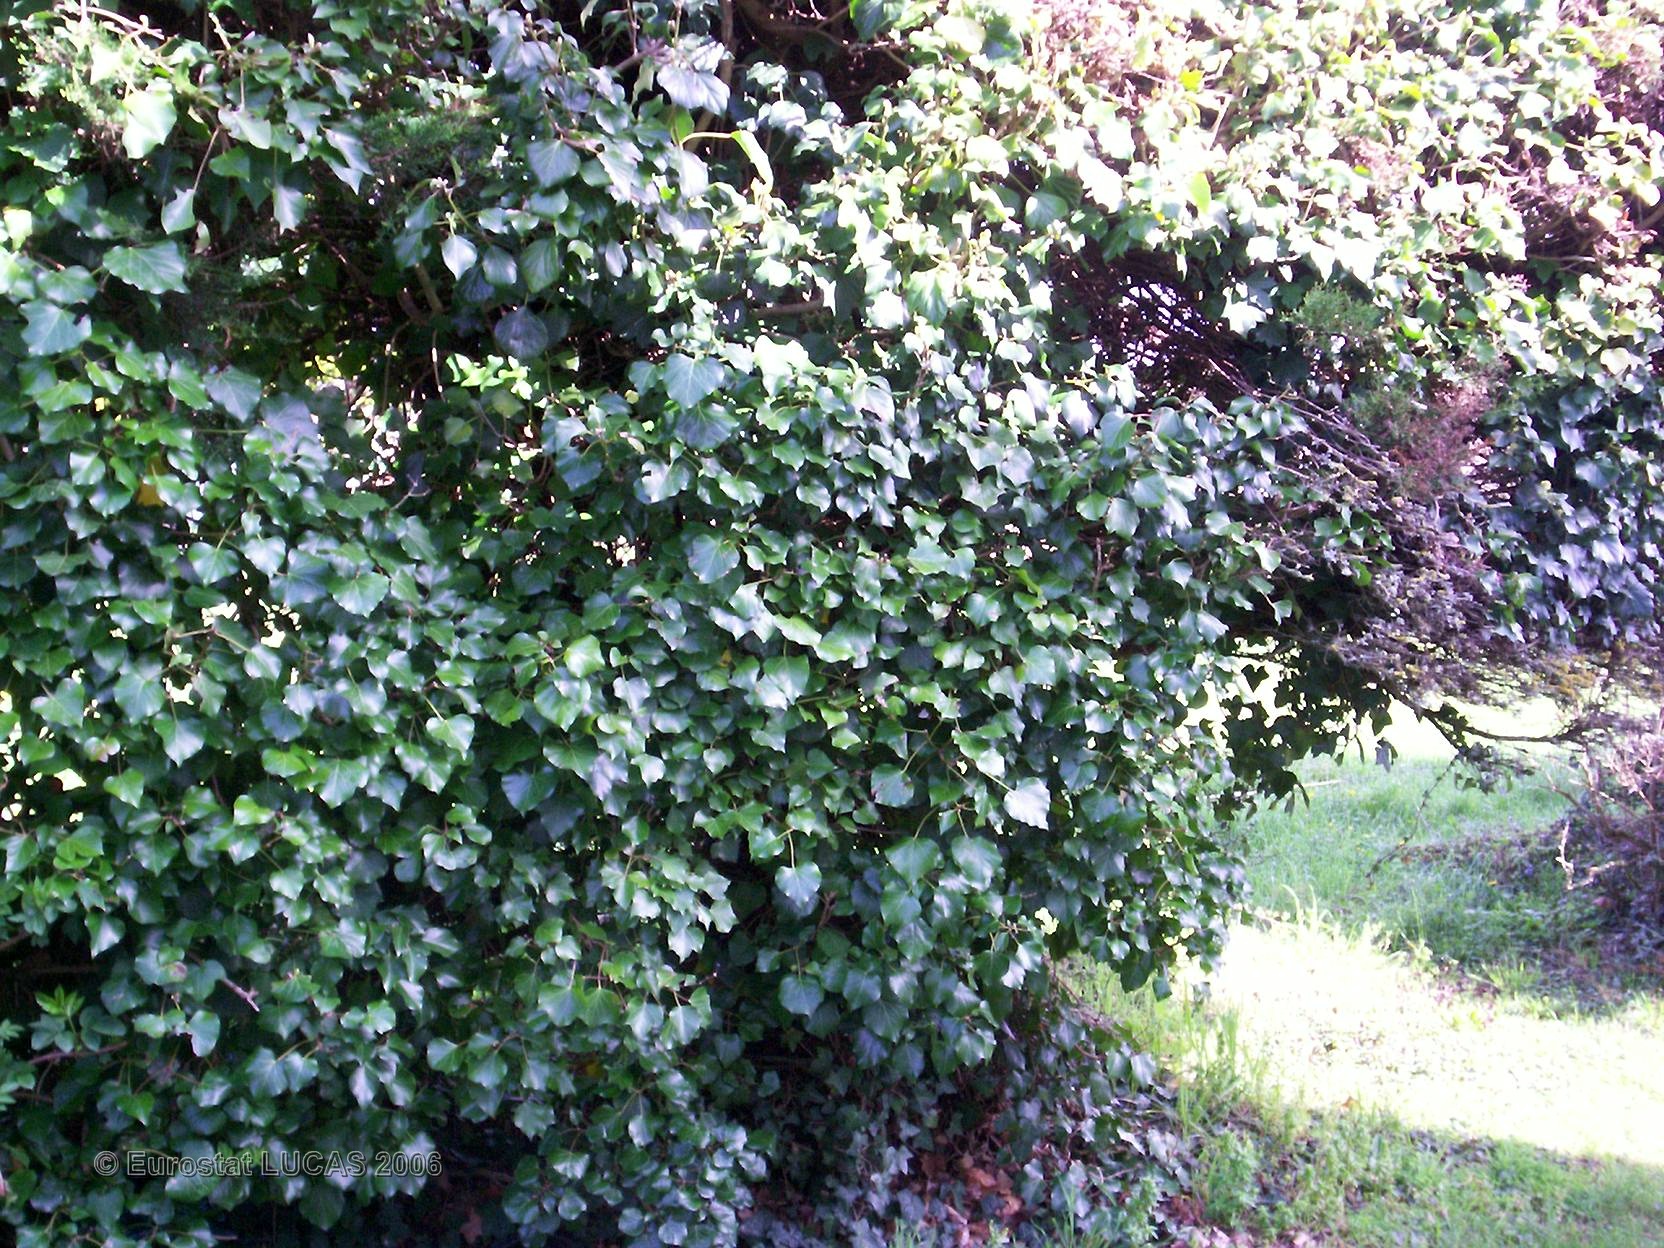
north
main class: Grassland
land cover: Grassland without tree/shrub cover
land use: Residential
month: April
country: FR
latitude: 47.7059
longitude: -3.4411
